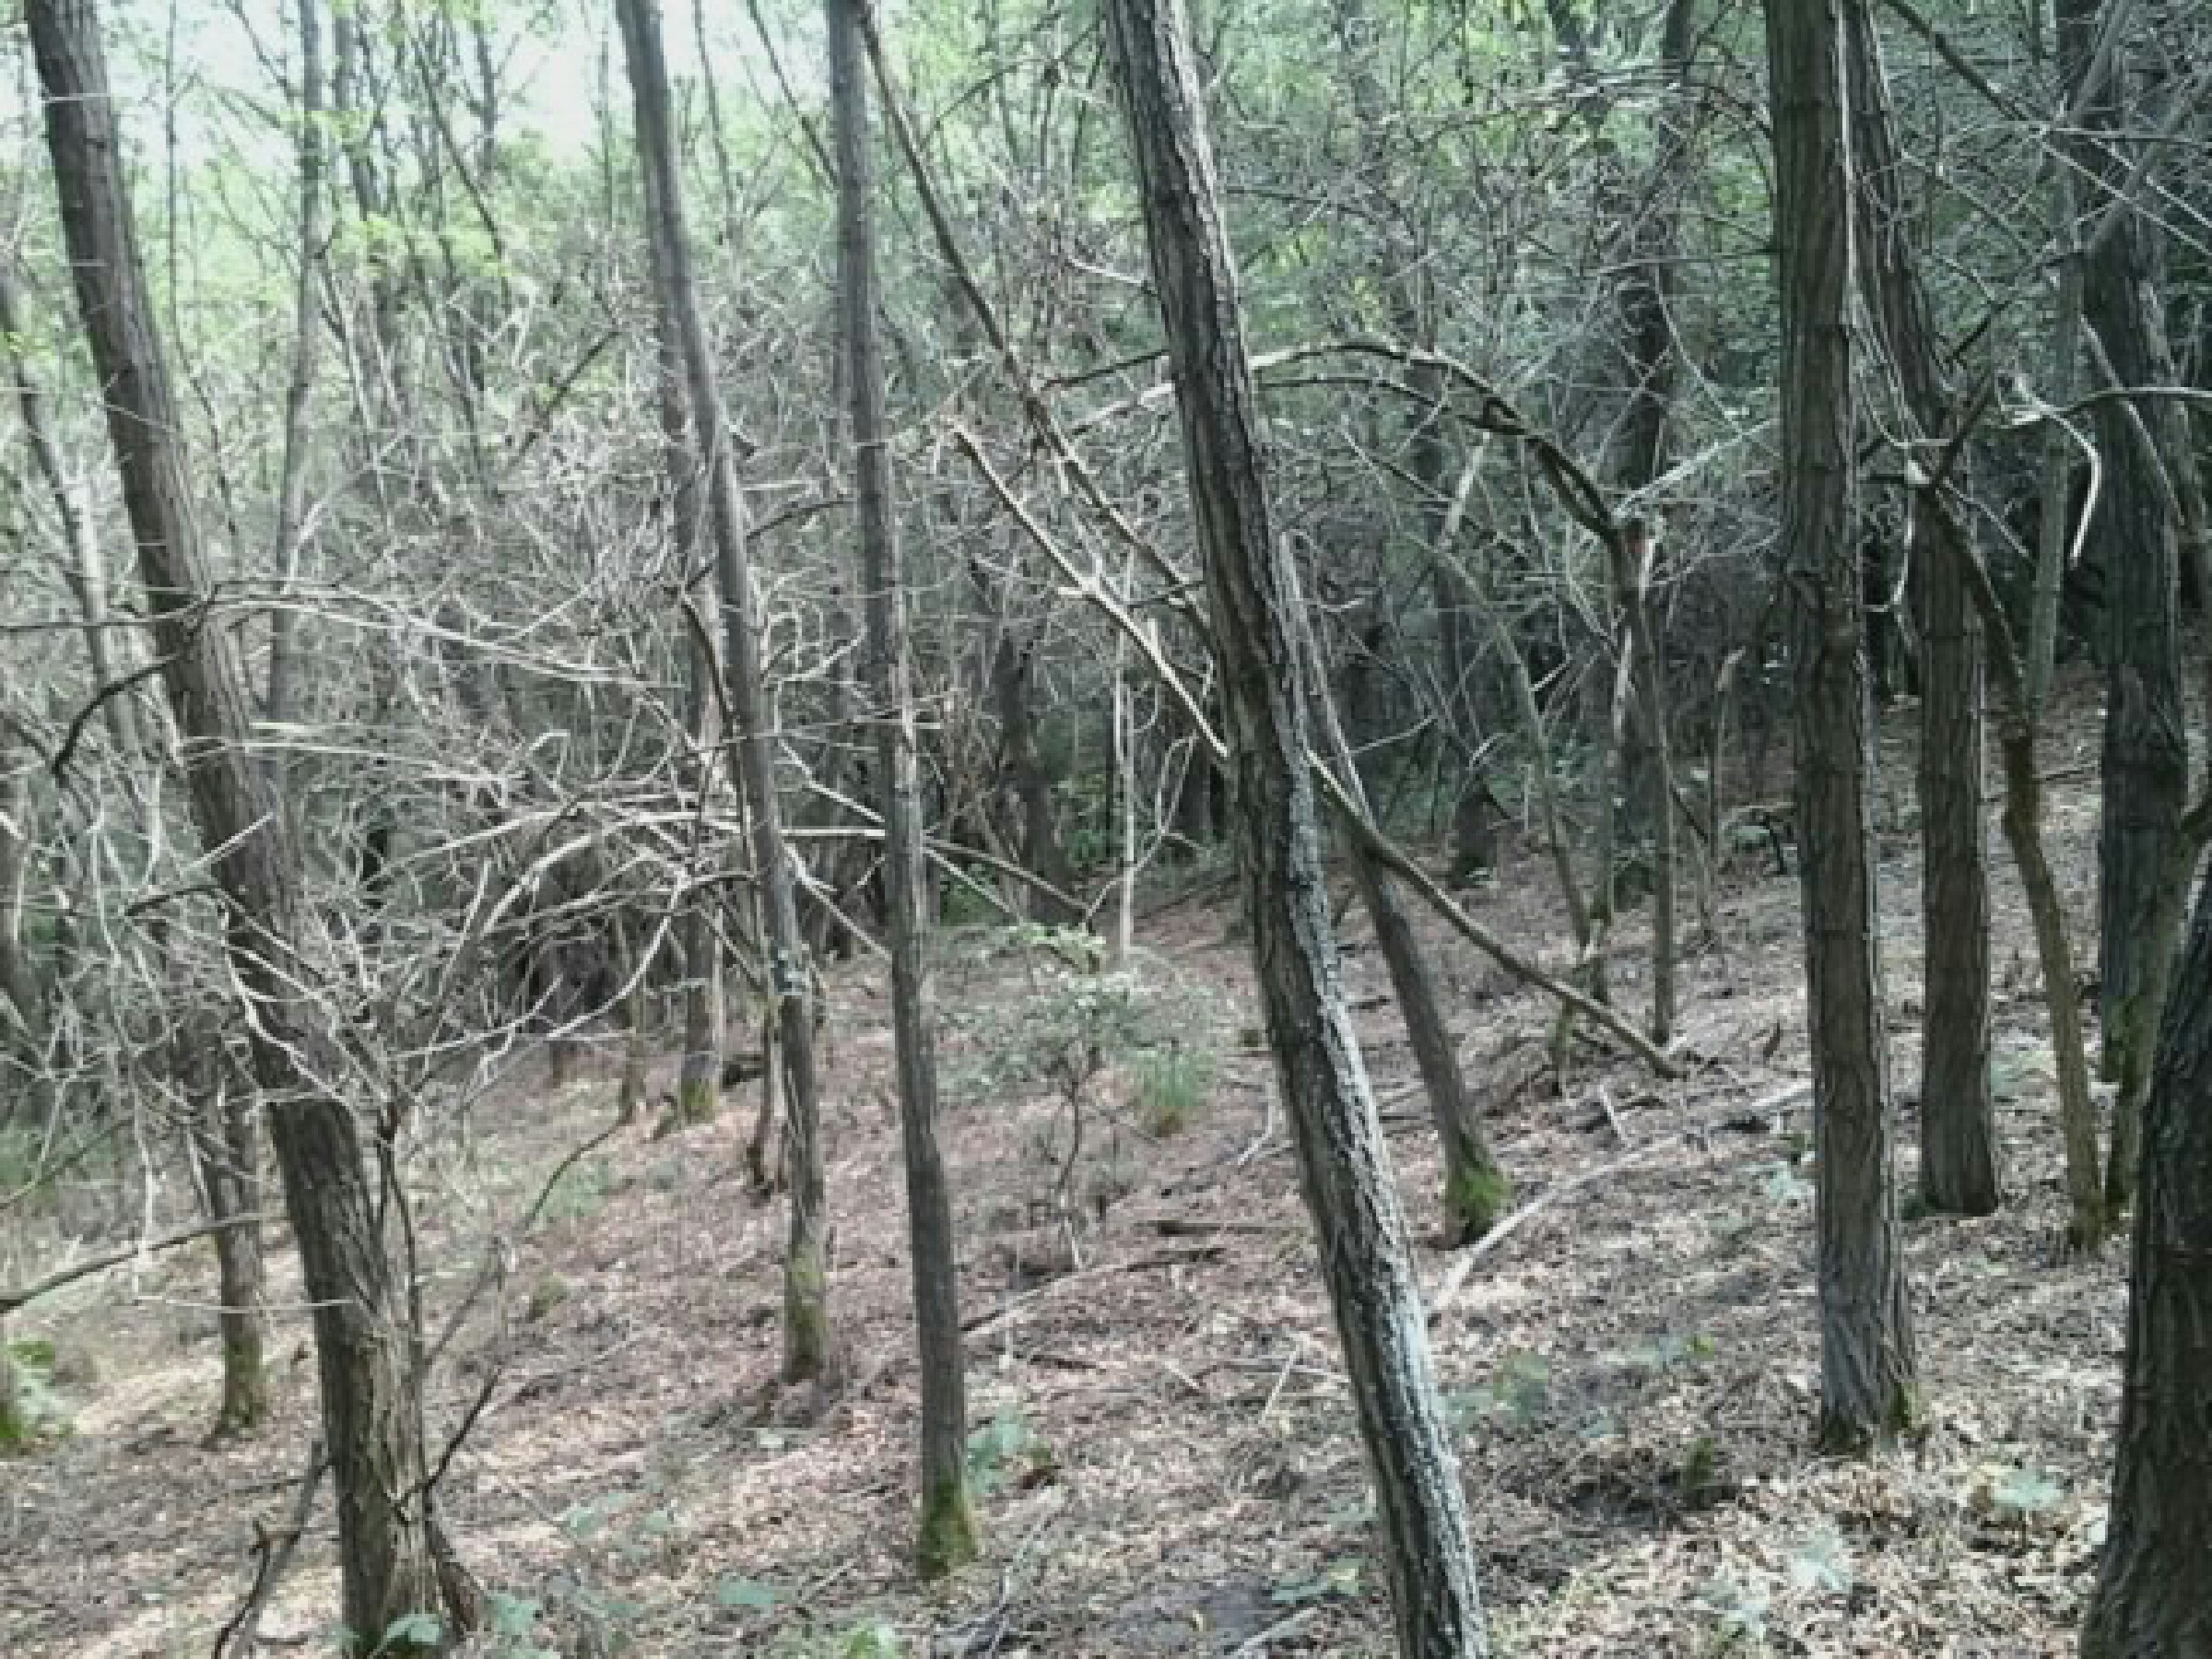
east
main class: Woodland
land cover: Broadleaved woodland
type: exotic forest
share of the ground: > 75 %
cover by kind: broadleaved forest trees 100 %
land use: Forestry
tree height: > 5 m
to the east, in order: Broadleaved woodland; Tracks; Broadleaved woodland
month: August
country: HU
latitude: 47.8535
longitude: 19.4446
